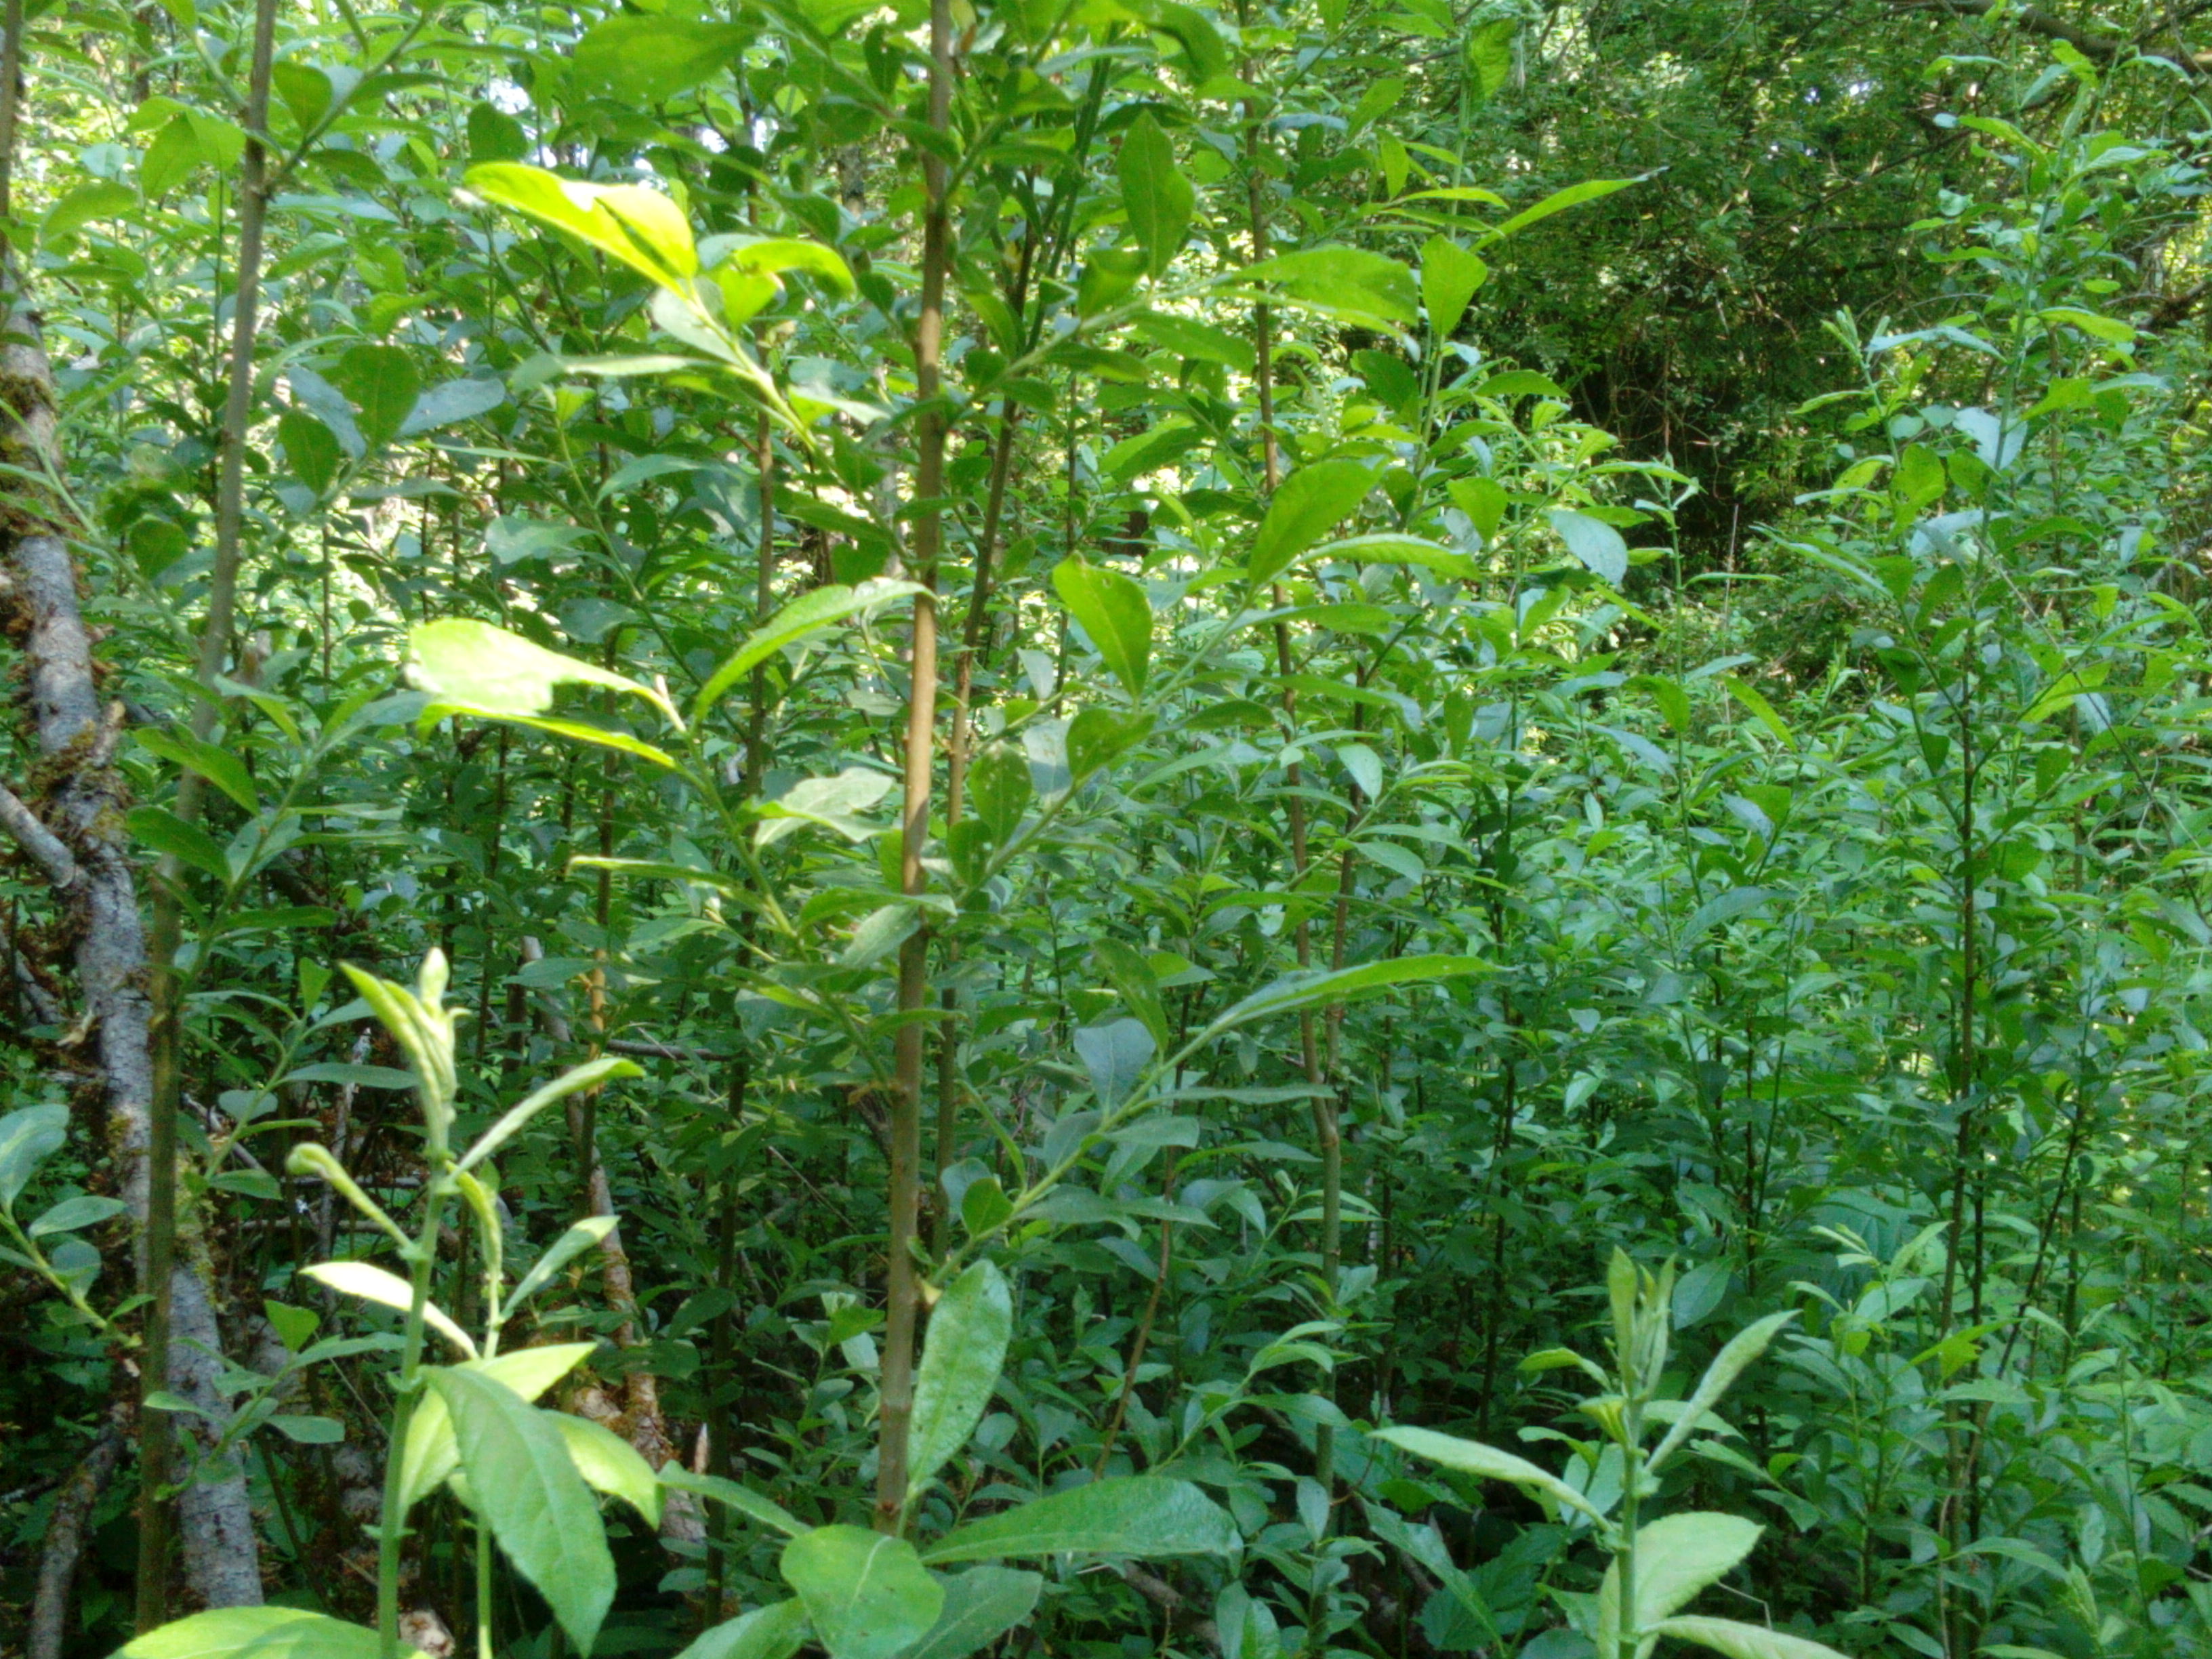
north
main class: Woodland
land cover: Spruce dominated mixed woodland
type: hemiboreal forest and nemoral coniferous forest and mixed broadleaved-coniferous forest
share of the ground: > 75 %
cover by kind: coniferous forest trees 50 %, broadleaved forest trees 50 %
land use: Forestry
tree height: > 5 m
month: June
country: LV
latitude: 56.8323
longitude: 22.2951
